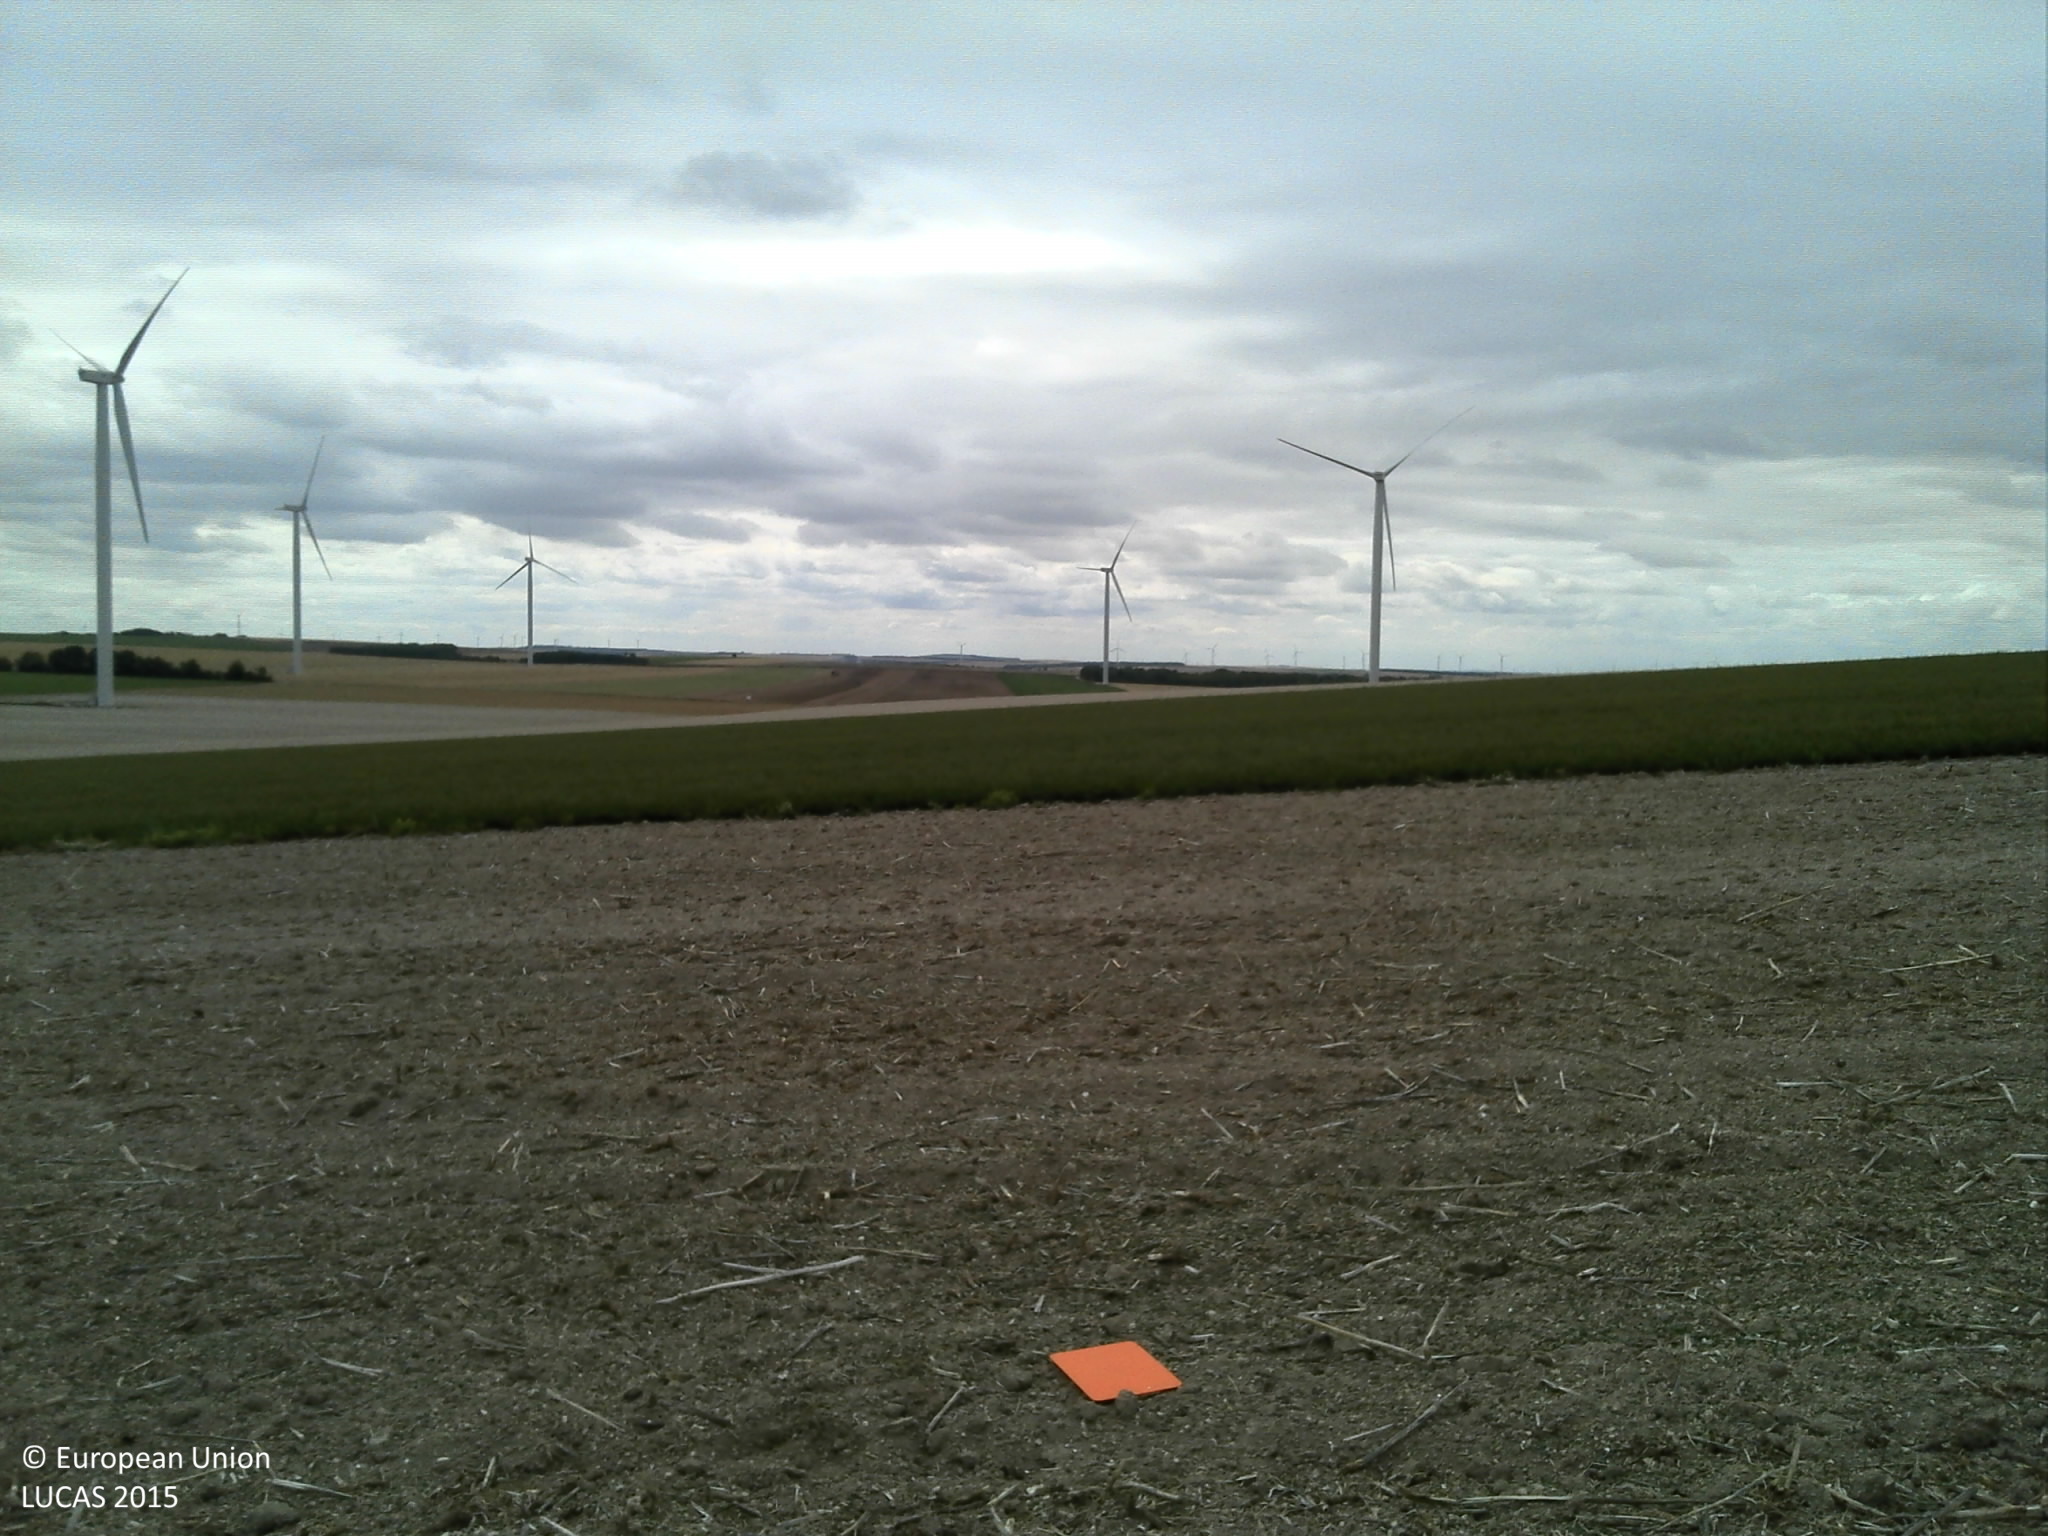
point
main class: Cropland
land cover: Rape and turnip rape
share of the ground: < 10 %
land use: Agriculture (excluding fallow land and kitchen gardens)
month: August
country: FR
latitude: 48.4853
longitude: 4.1921
